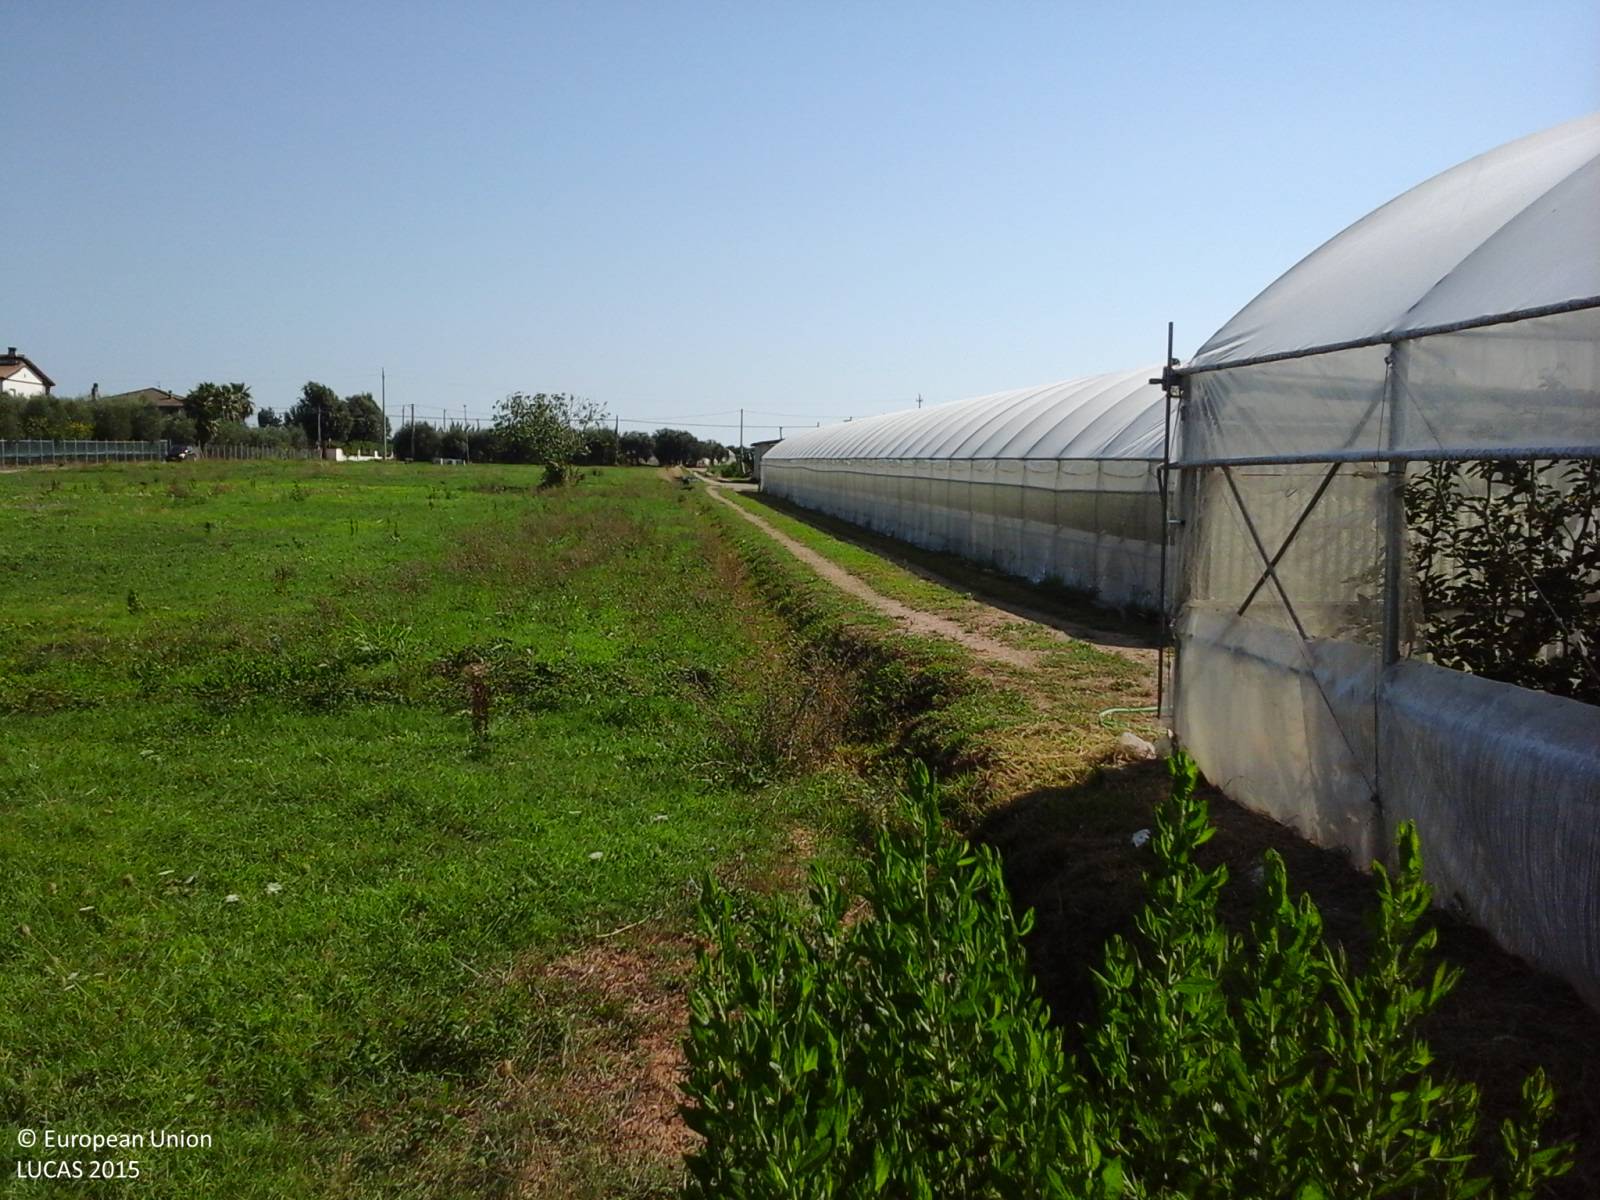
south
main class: Artificial land
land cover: Greenhouses
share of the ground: > 75 %
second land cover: Tomatoes
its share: > 75 %
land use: Agriculture (excluding fallow land and kitchen gardens)
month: August
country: IT
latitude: 41.3156
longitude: 13.3194
